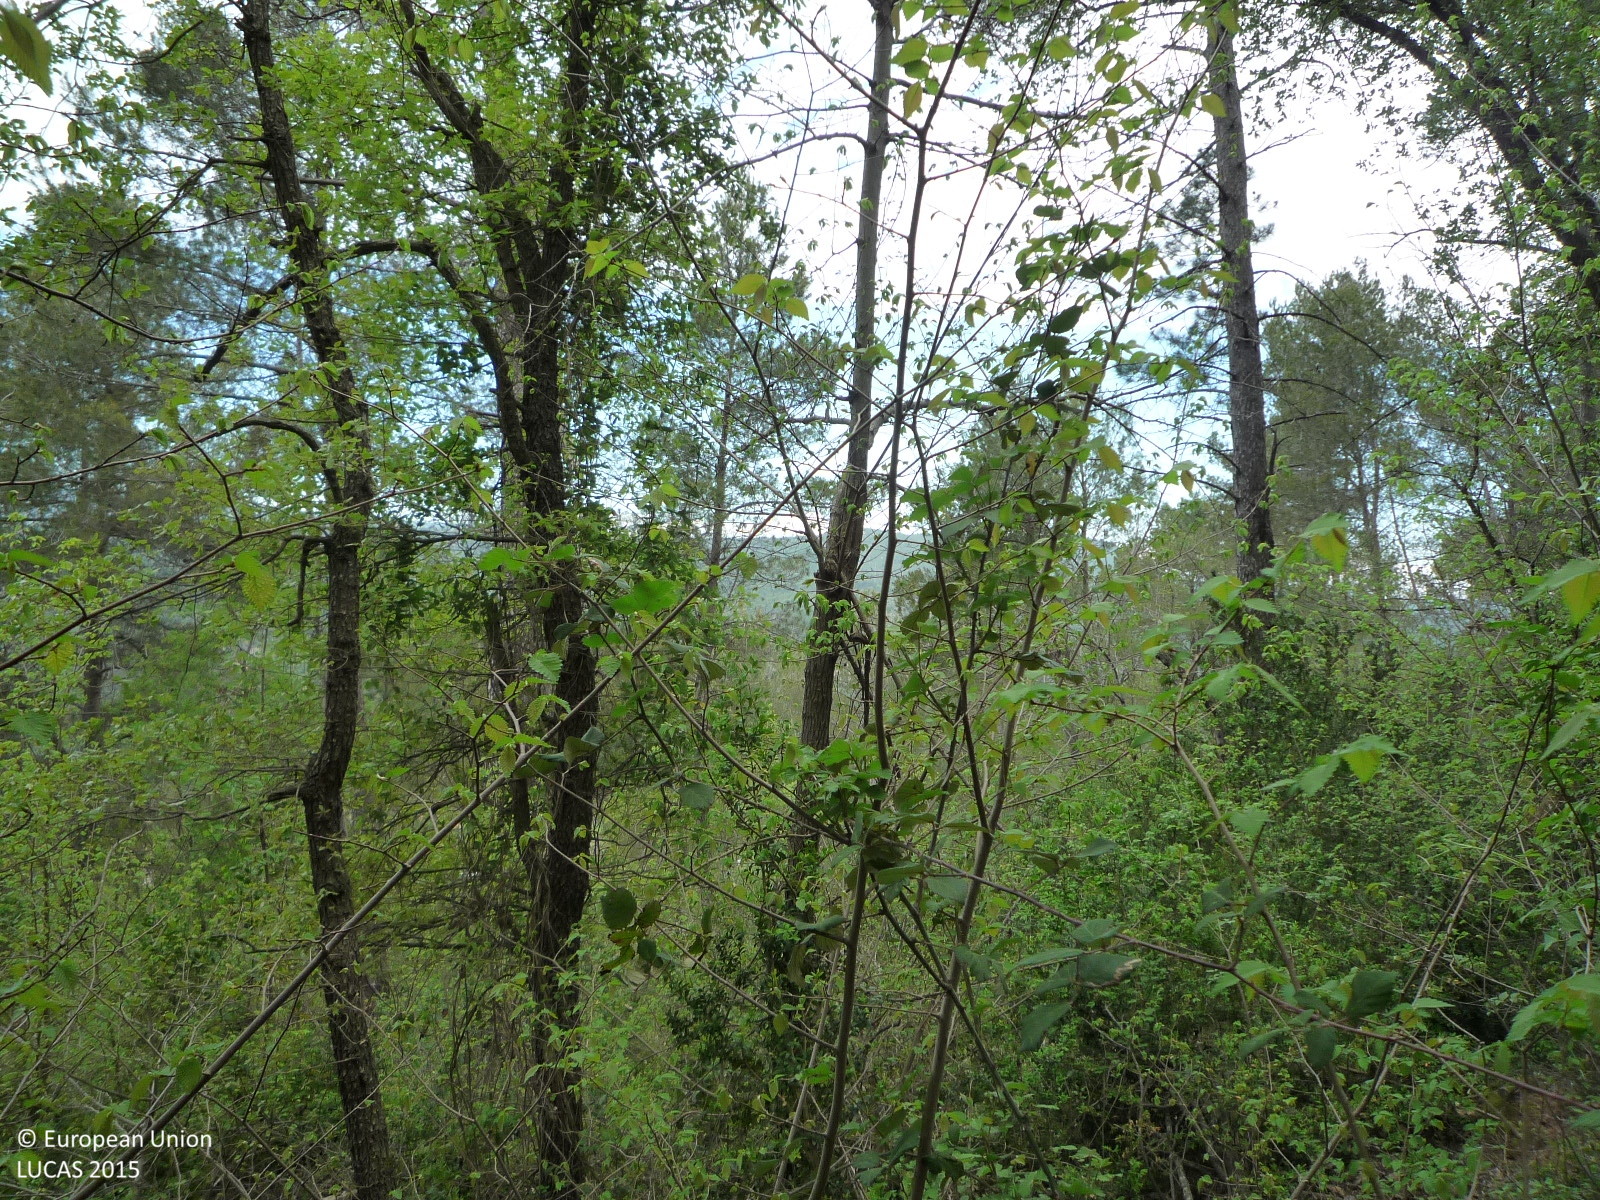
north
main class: Woodland
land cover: Pine dominated mixed woodland
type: coniferous forest of the mediterranean region
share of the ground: > 75 %
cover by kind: coniferous forest trees 75 %, broadleaved forest trees 25 %
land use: Forestry
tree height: > 5 m
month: April
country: ES
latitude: 41.7307
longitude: 1.6834
